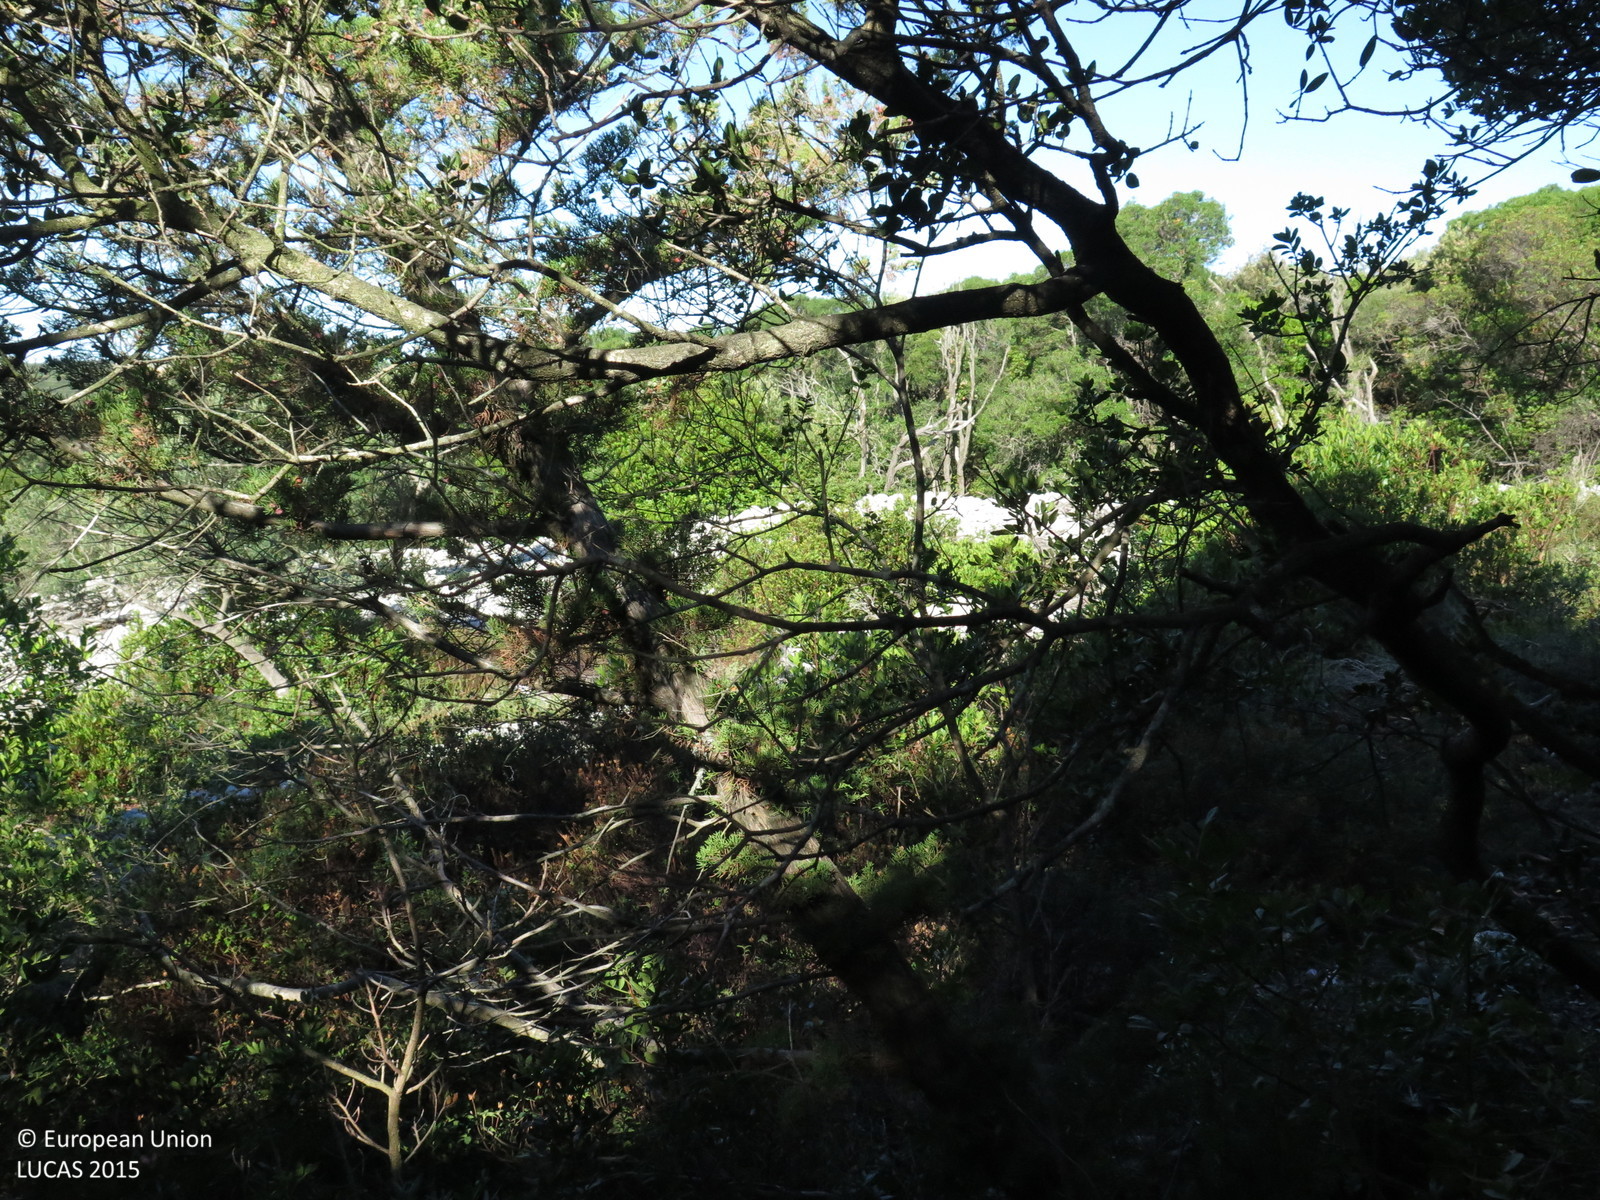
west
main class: Shrubland
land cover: Shrubland with sparse tree cover
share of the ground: > 75 %
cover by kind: shrubs 90 %, broadleaved forest trees 5 %, unconsolidated bare surface 5 %
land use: Semi-natural and natural areas not in use
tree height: > 5 m
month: September
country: HR
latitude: 44.5817
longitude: 14.4139
